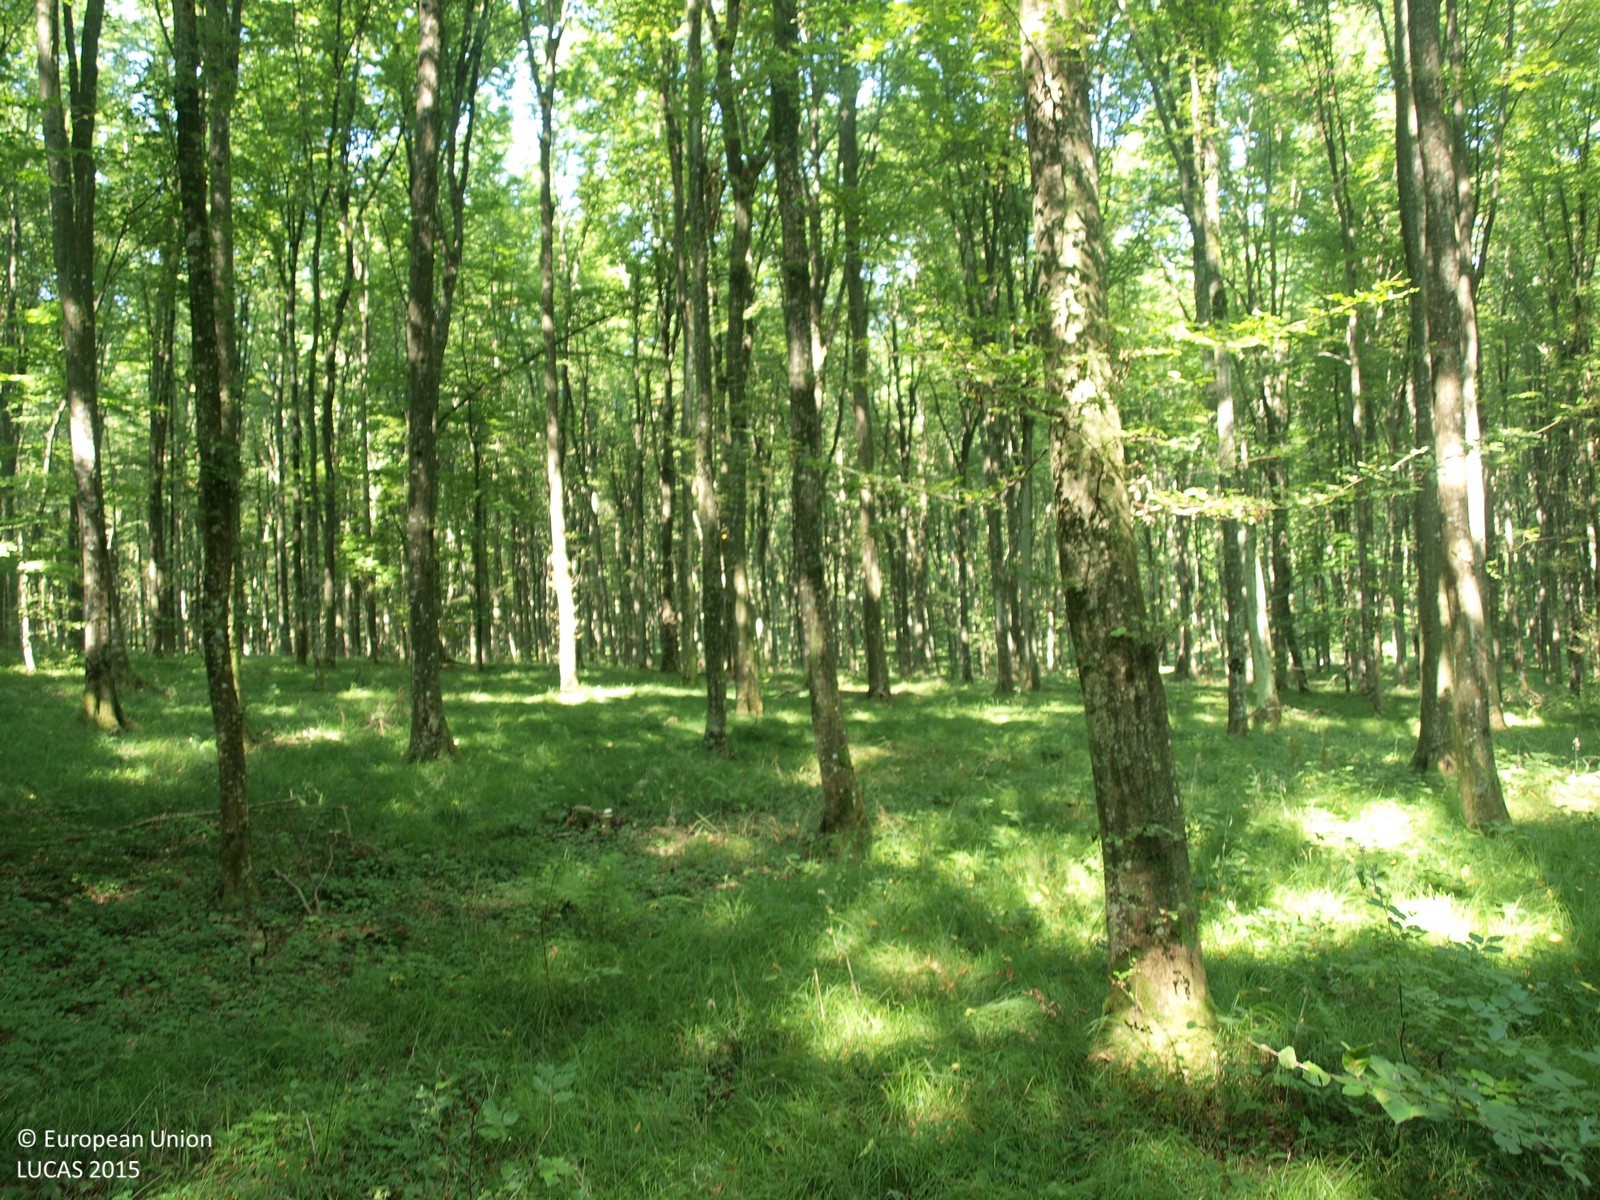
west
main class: Woodland
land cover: Broadleaved woodland
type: mesophytic deciduous forest
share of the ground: > 75 %
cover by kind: broadleaved forest trees 100 %
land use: Forestry
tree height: > 5 m
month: August
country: HR
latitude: 45.9327
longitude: 16.5642
